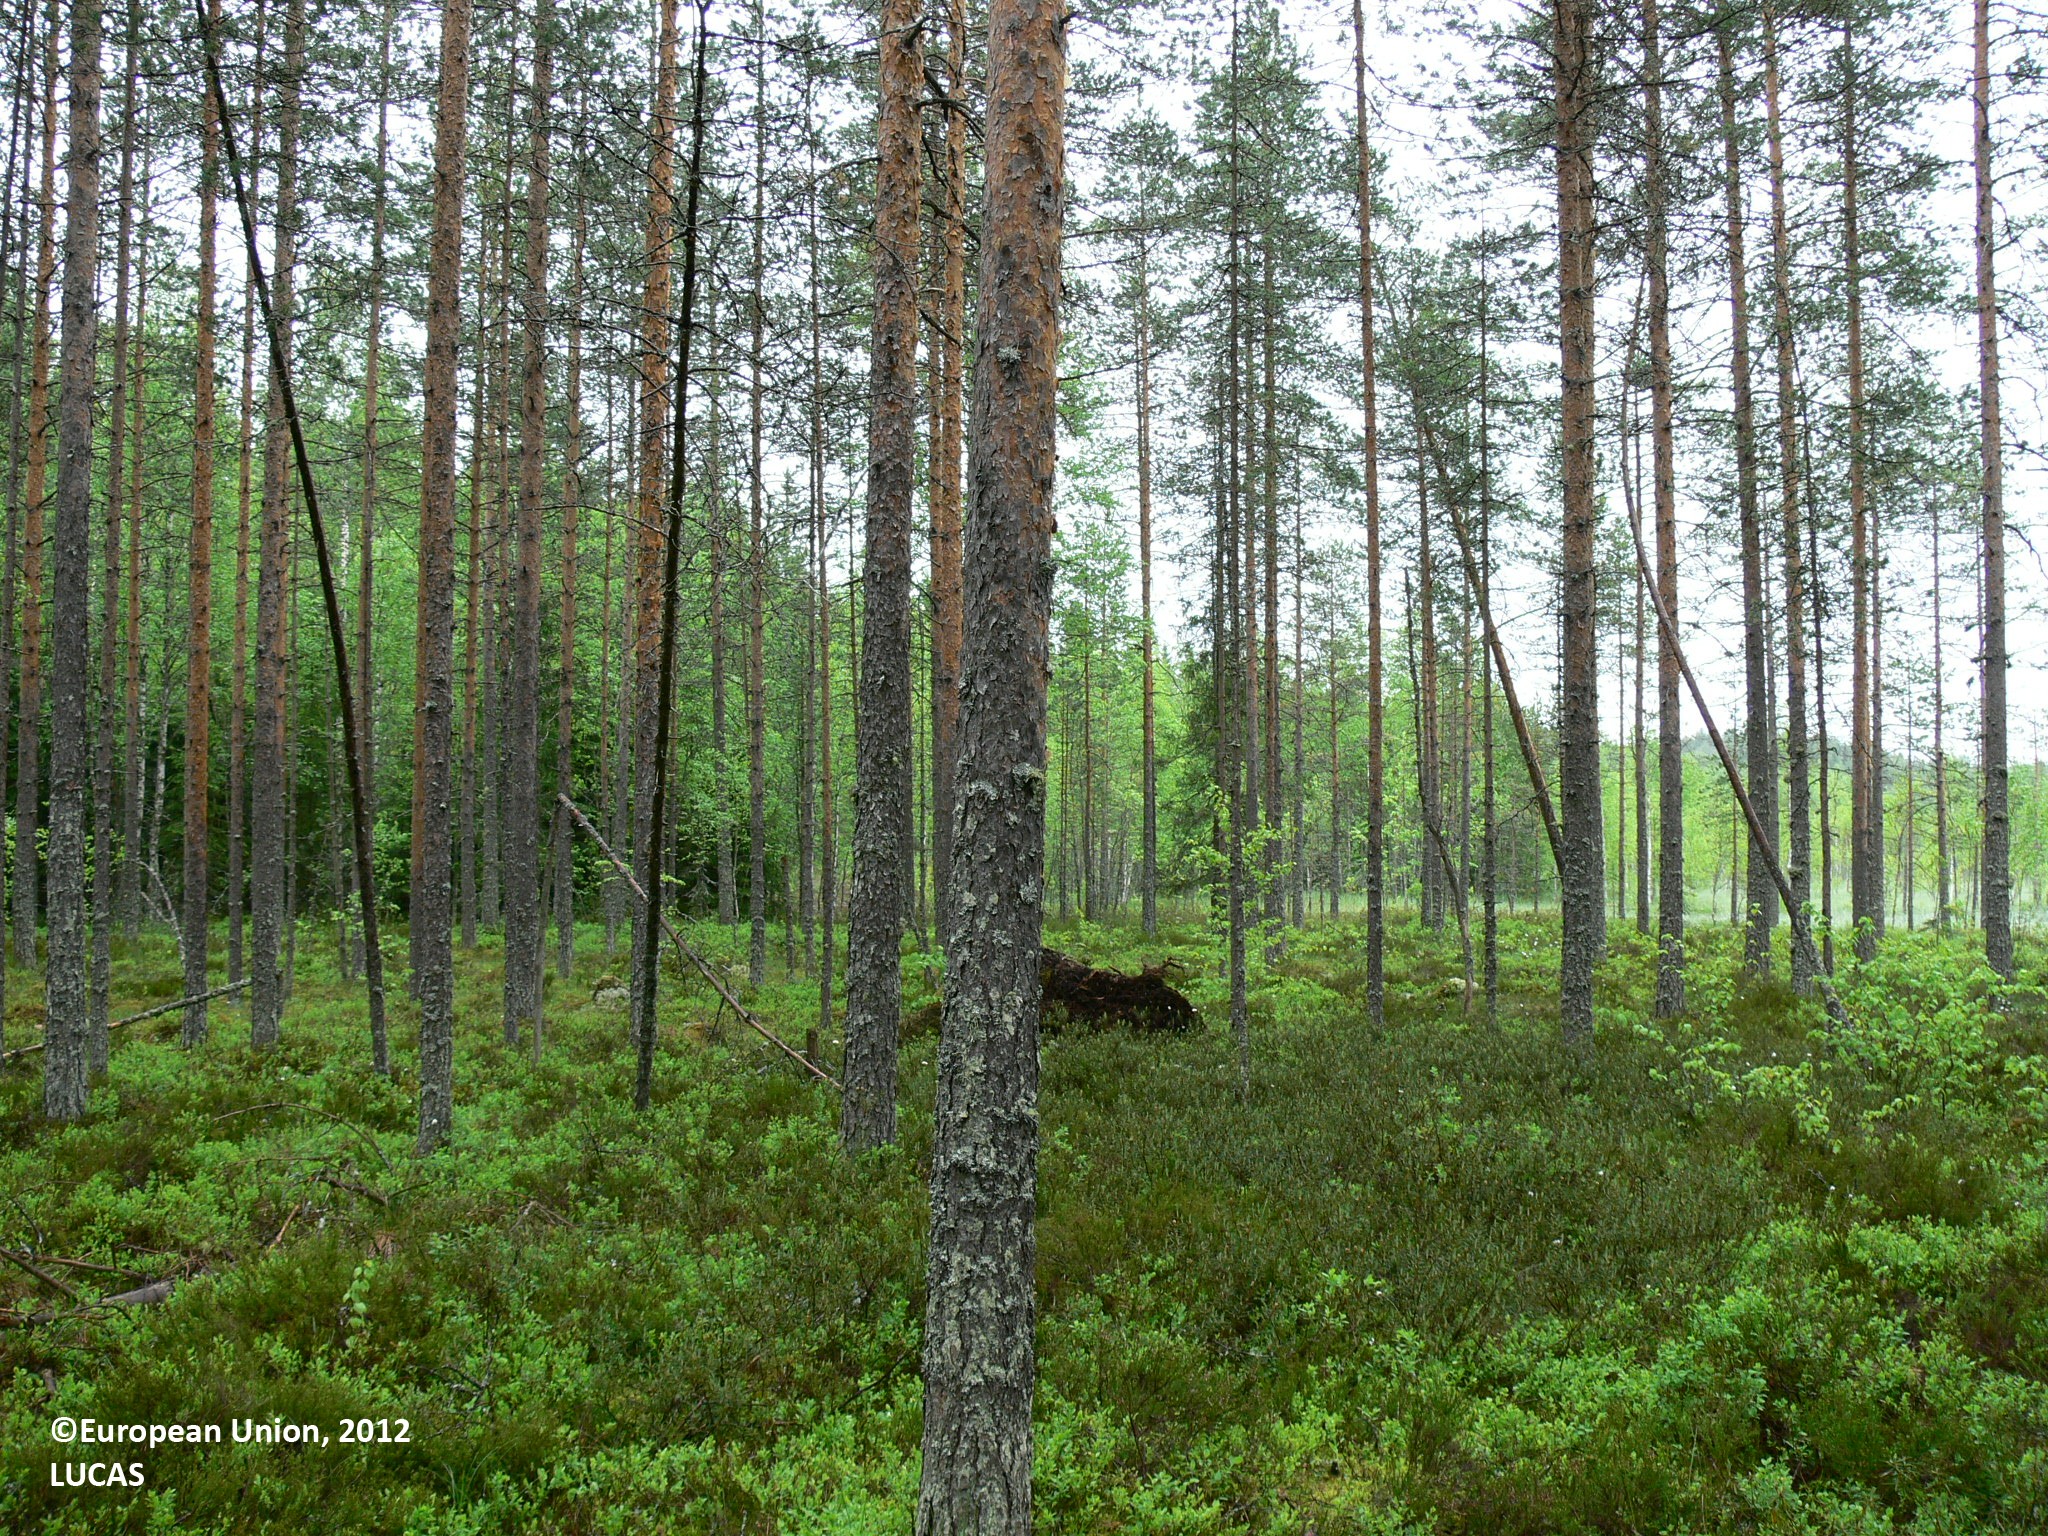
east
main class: Woodland
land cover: Pine dominated coniferous woodland
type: boreal forest
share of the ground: > 75 %
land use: Forestry
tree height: > 5 m
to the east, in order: Pine dominated coniferous woodland; Other mixed woodland; Inland running water; Other mixed woodland; Other coniferous woodland; Other mixed woodland; Tracks; Other mixed woodland
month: June
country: FI
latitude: 62.4873
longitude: 30.2380
